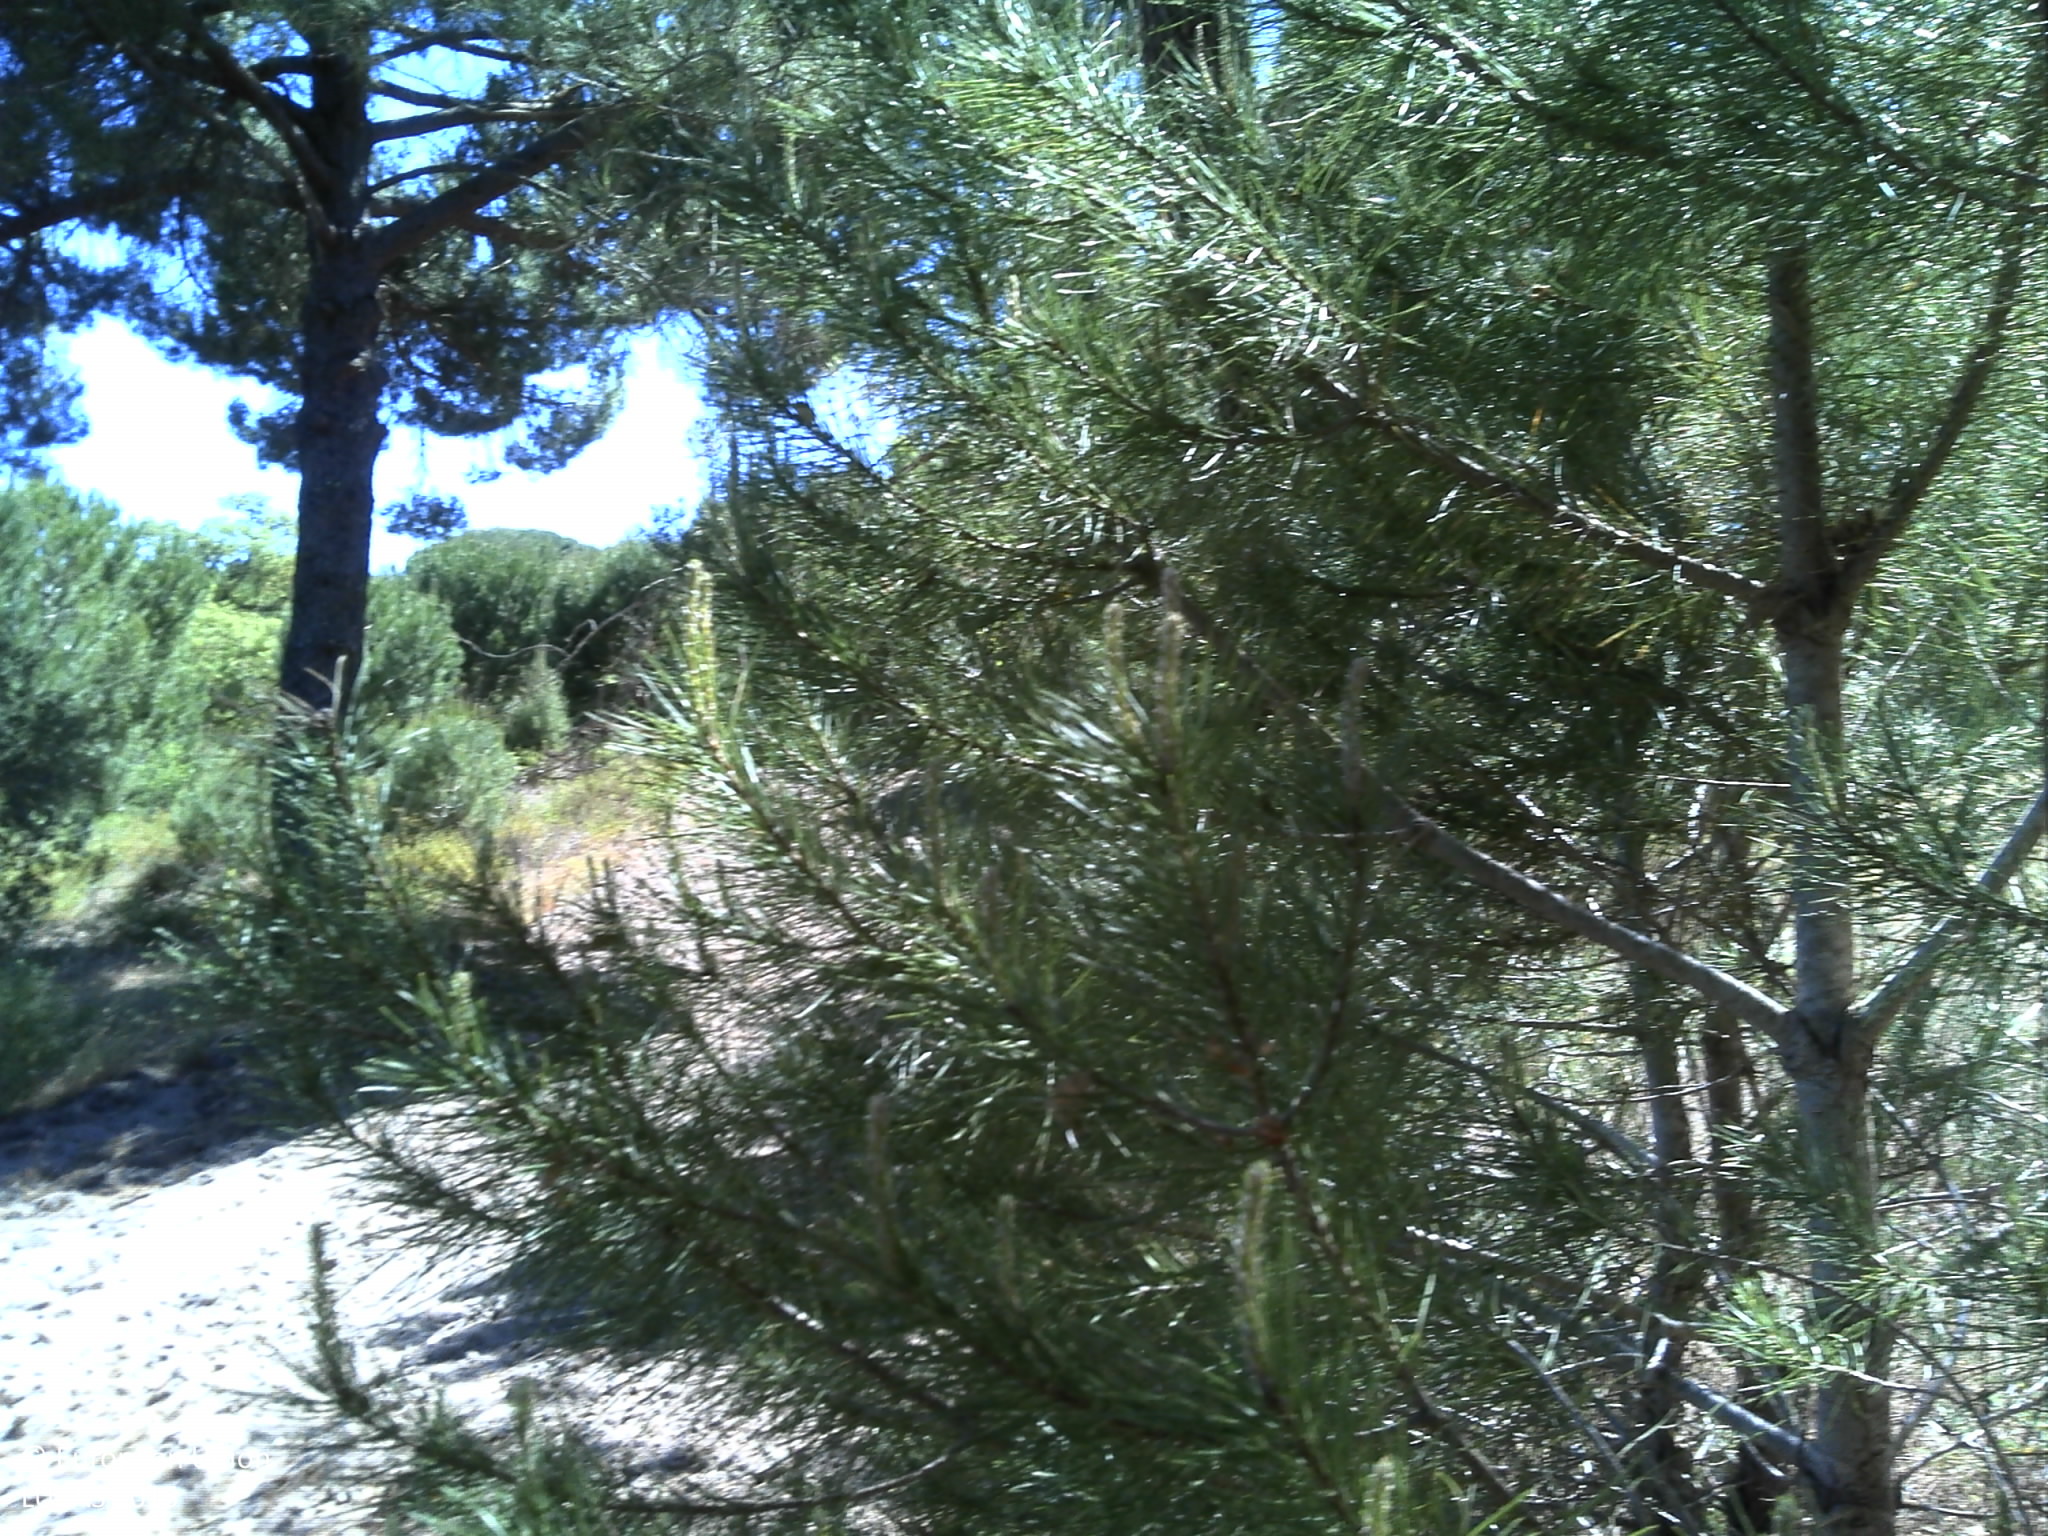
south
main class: Woodland
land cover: Pine dominated coniferous woodland
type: coniferous forest of the mediterranean region
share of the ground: 10 - 25 %
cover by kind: herbaceous plants 60 %, coniferous forest trees 20 %, unconsolidated bare surface 20 %
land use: Forestry
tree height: > 5 m
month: May
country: PT
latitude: 38.6001
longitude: -8.5073
